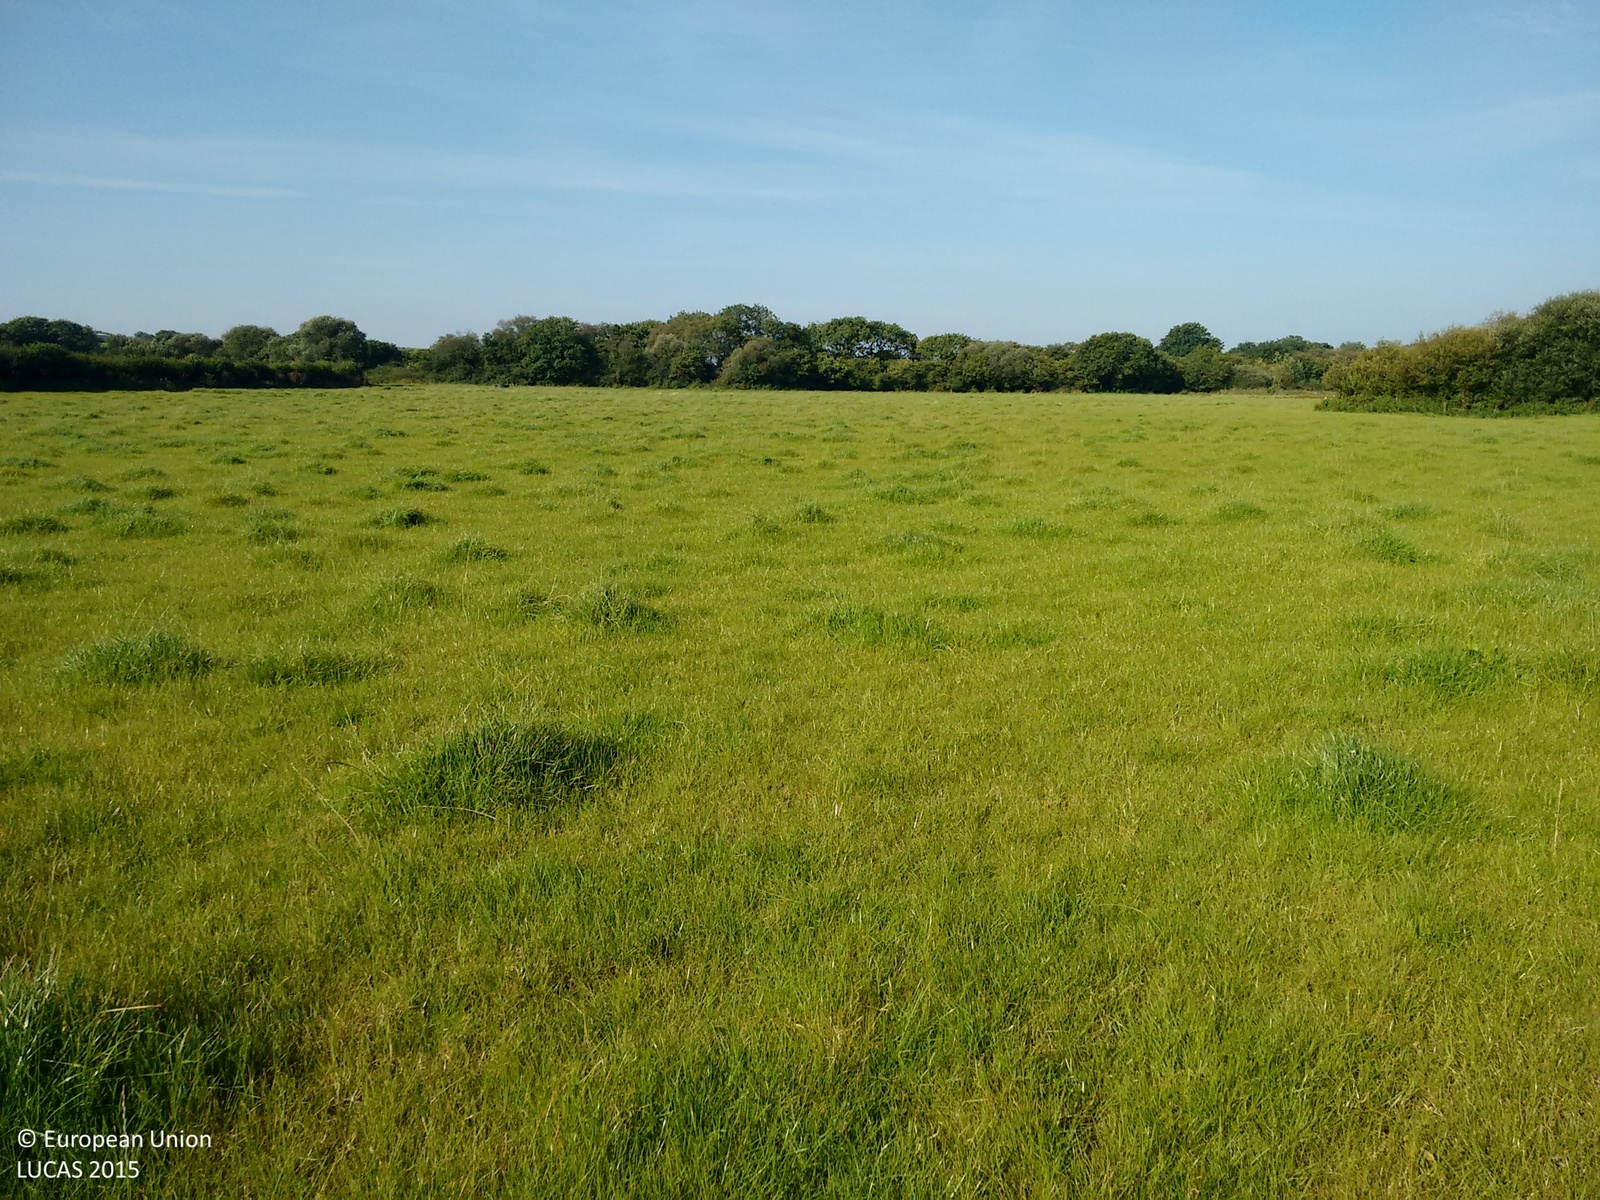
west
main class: Grassland
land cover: Grassland without tree/shrub cover
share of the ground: > 75 %
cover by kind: herbaceous plants 100 %
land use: Agriculture (excluding fallow land and kitchen gardens)
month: September
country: GB
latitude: 50.8140
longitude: -4.4238
